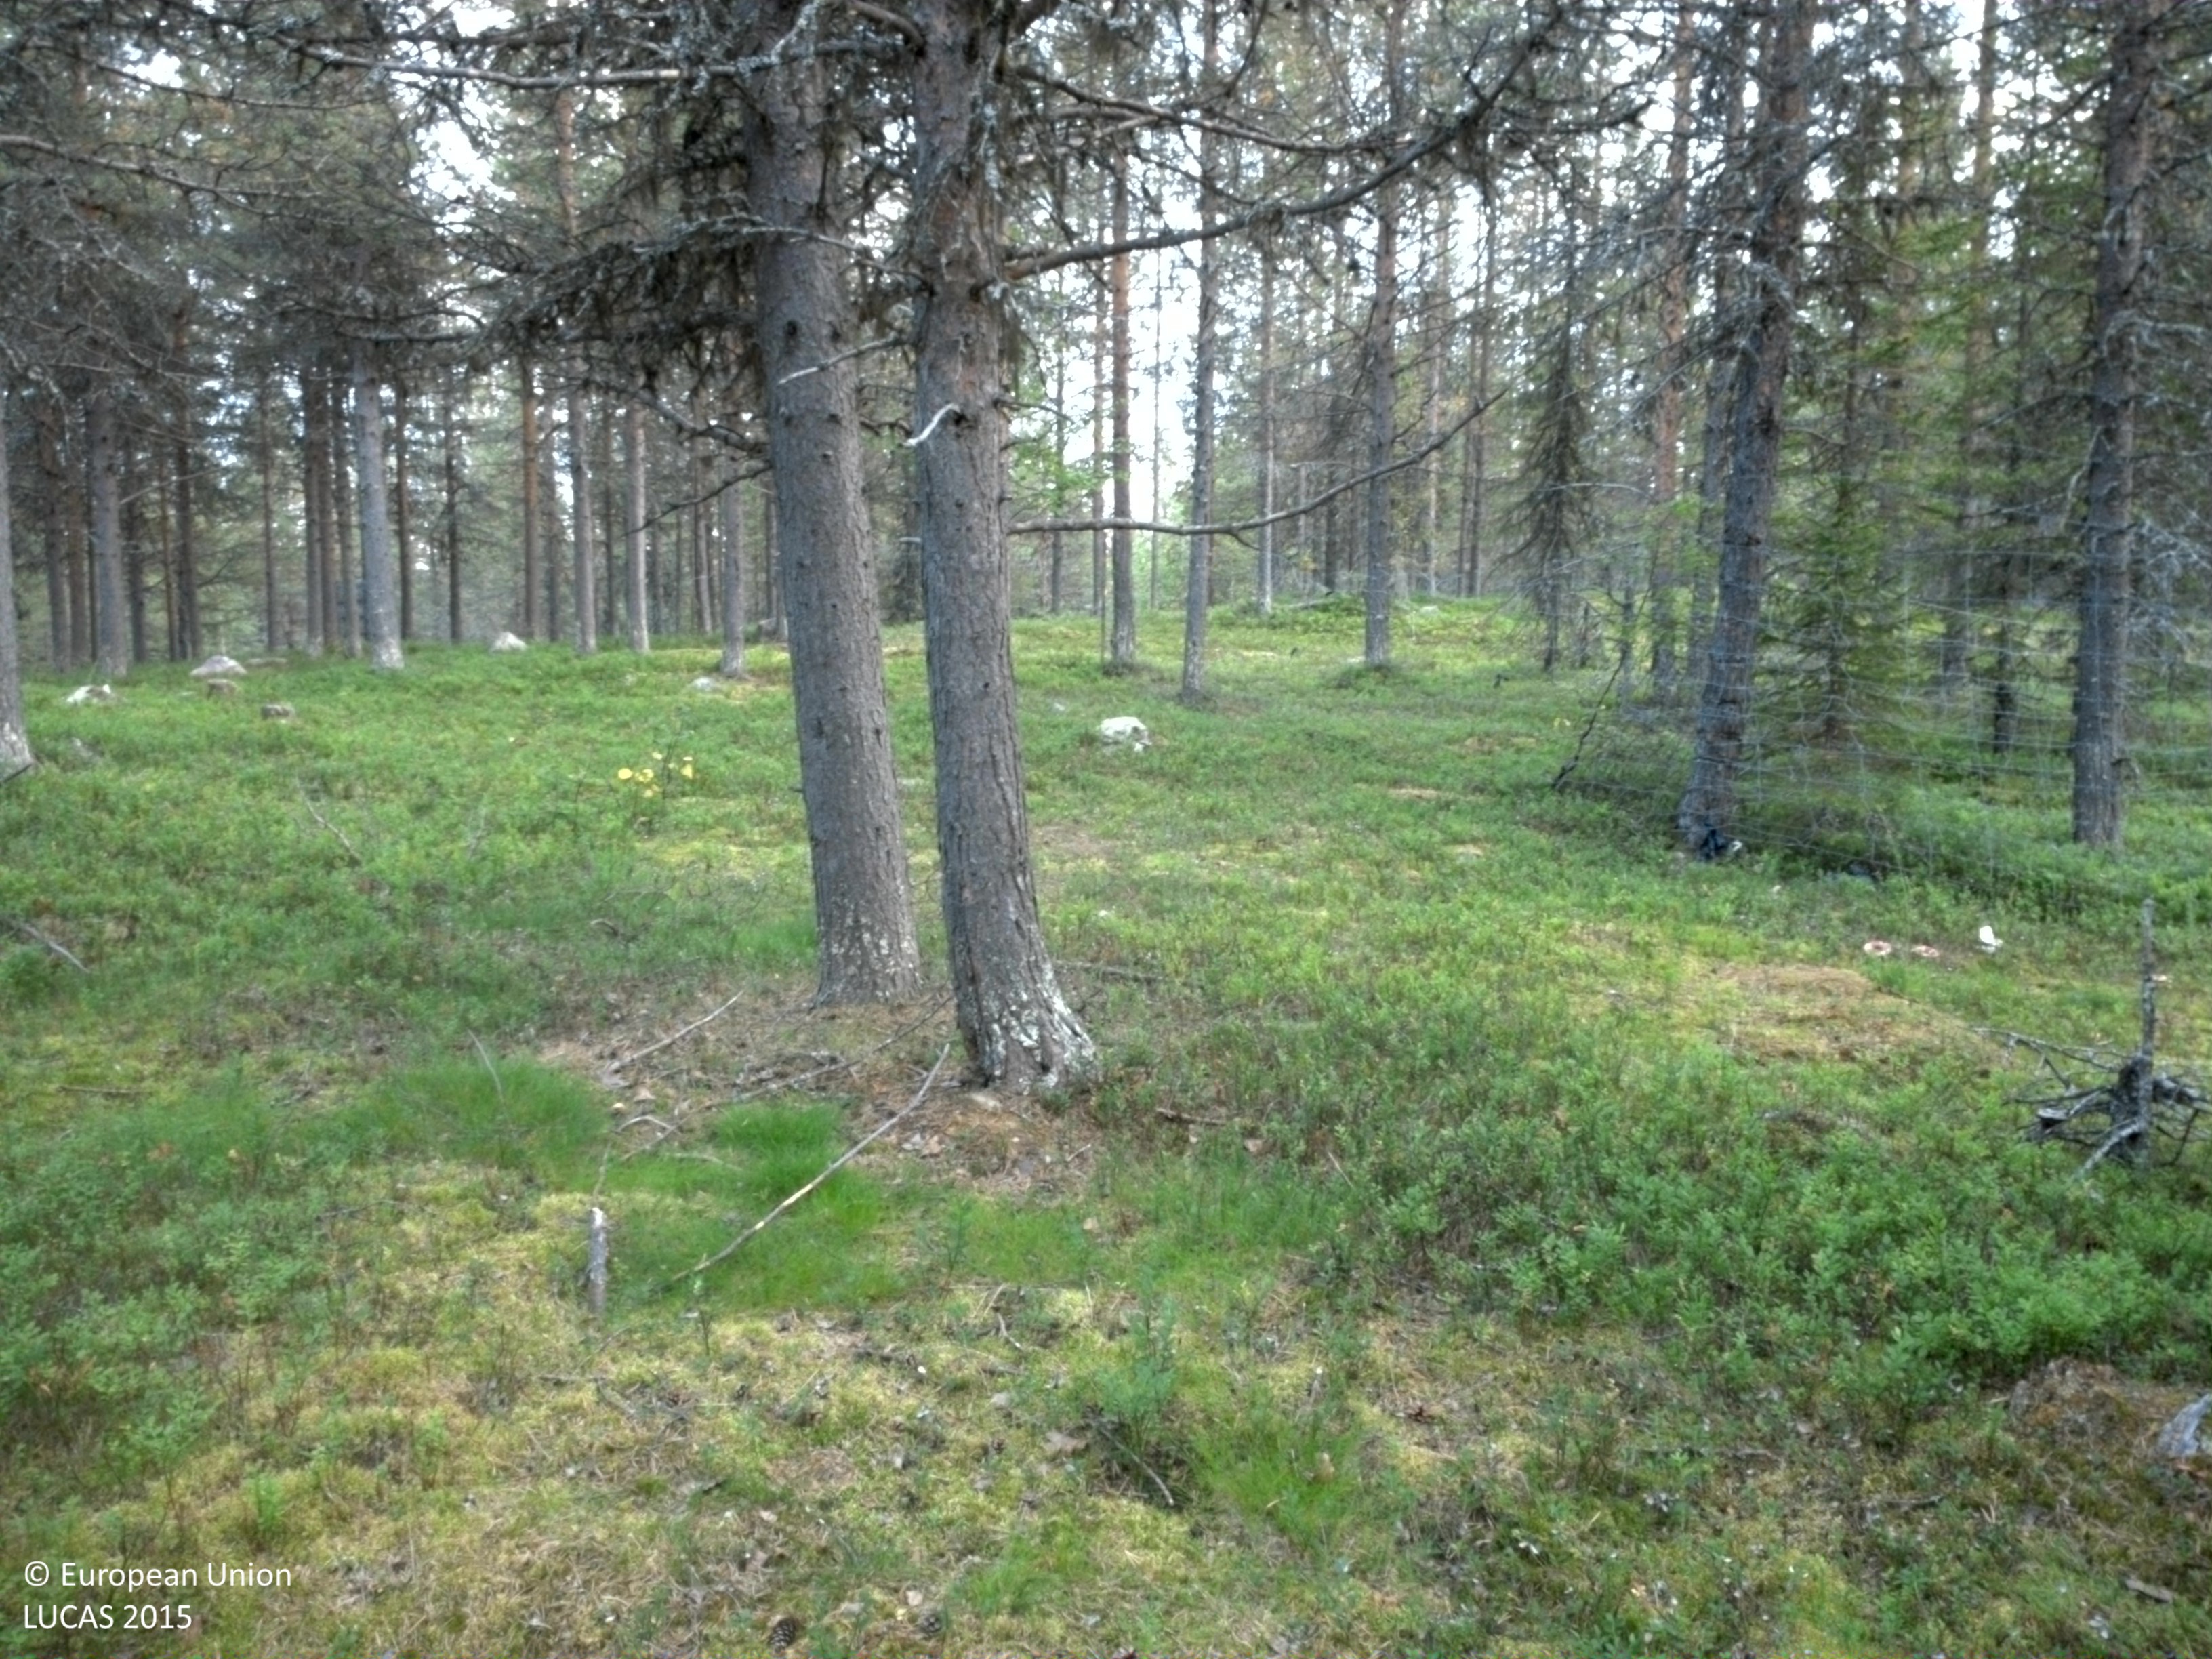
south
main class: Woodland
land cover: Pine dominated coniferous woodland
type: boreal forest
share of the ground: 25 - 50 %
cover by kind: shrubs 55 %, coniferous forest trees 30 %, broadleaved forest trees 5 %, herbaceous plants 5 %, lichens and mosses 5 %
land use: Forestry
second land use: Other primary production
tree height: > 5 m
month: August
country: SE
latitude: 66.6553
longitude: 20.6065
